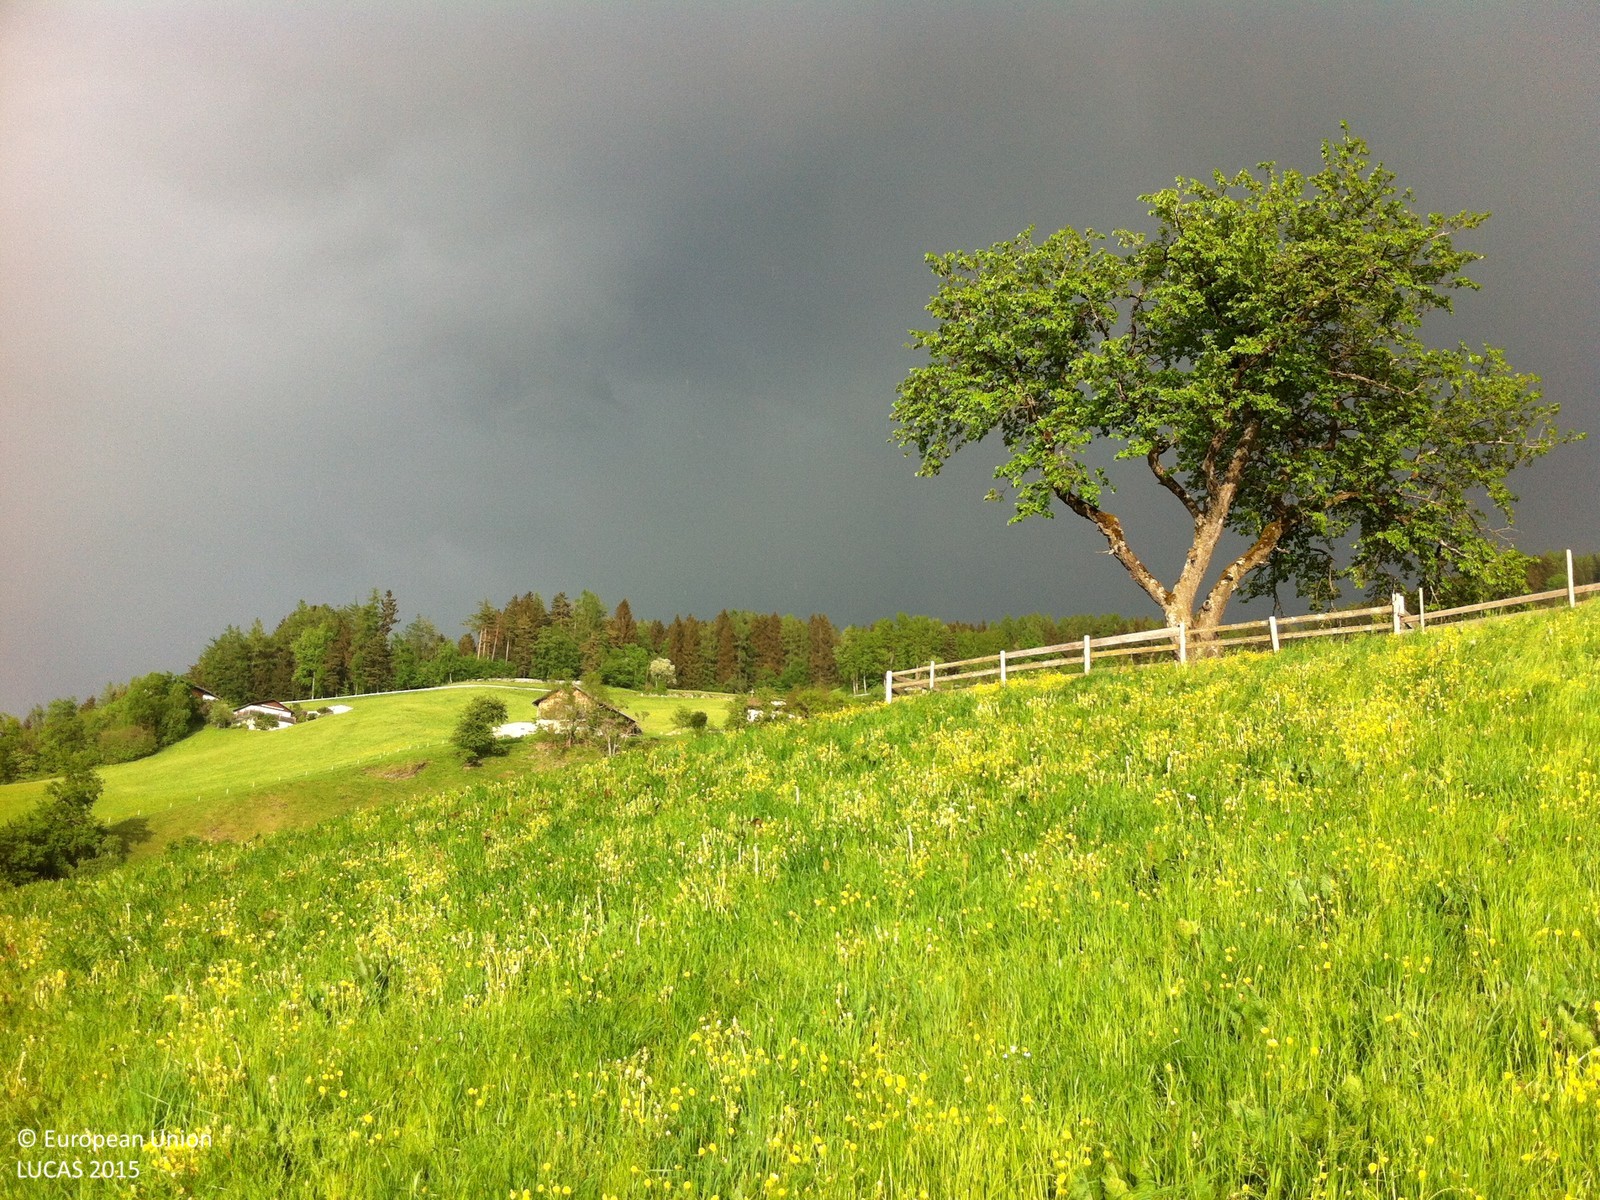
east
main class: Grassland
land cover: Grassland without tree/shrub cover
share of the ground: > 75 %
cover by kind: herbaceous plants 100 %
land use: Agriculture (excluding fallow land and kitchen gardens)
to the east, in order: Grassland without tree/shrub cover; Shrubland without tree cover; Tracks; Shruby margins; Ditches and canals; Grassland without tree/shrub cover; Paved roads, cycling and walking lanes; Shruby margins; Ditches and canals; Grassland without tree/shrub cover; Ditches and canals; Spruce dominated mixed woodland; Fences; Shrubland with sparse tree cover; Spruce dominated mixed woodland
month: May
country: AT
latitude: 47.2762
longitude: 11.5717
